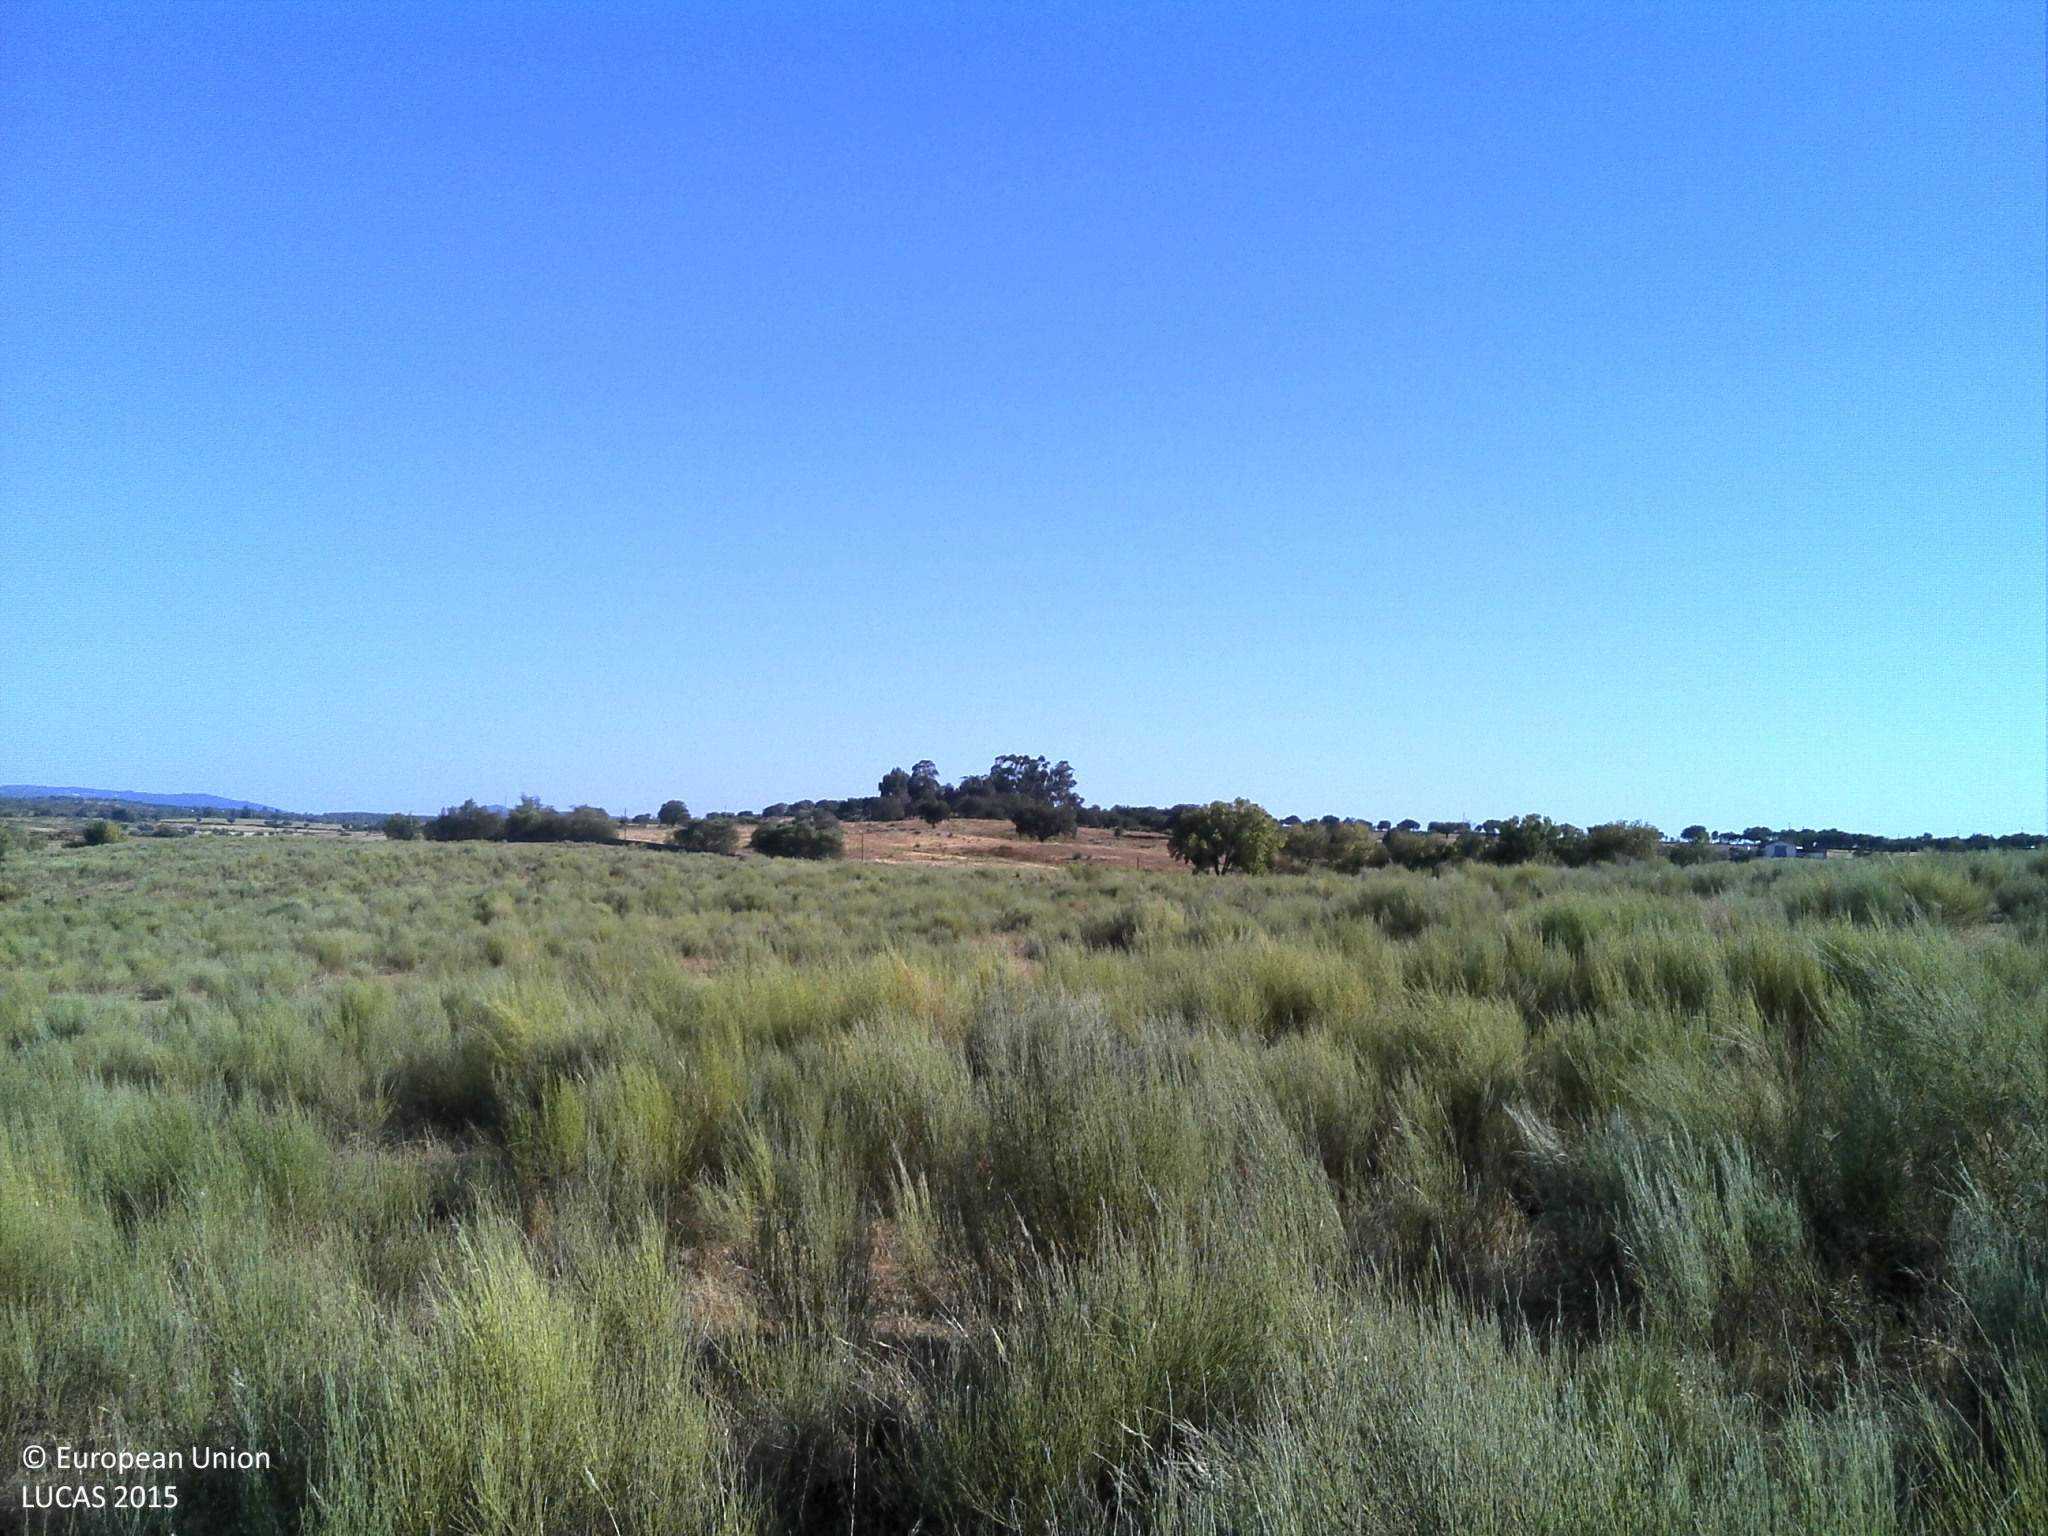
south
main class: Shrubland
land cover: Shrubland without tree cover
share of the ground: 25 - 50 %
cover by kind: unconsolidated bare surface 50 %, shrubs 30 %, herbaceous plants 20 %
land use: Agriculture (excluding fallow land and kitchen gardens)
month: August
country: PT
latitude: 39.4360
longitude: -7.5082
